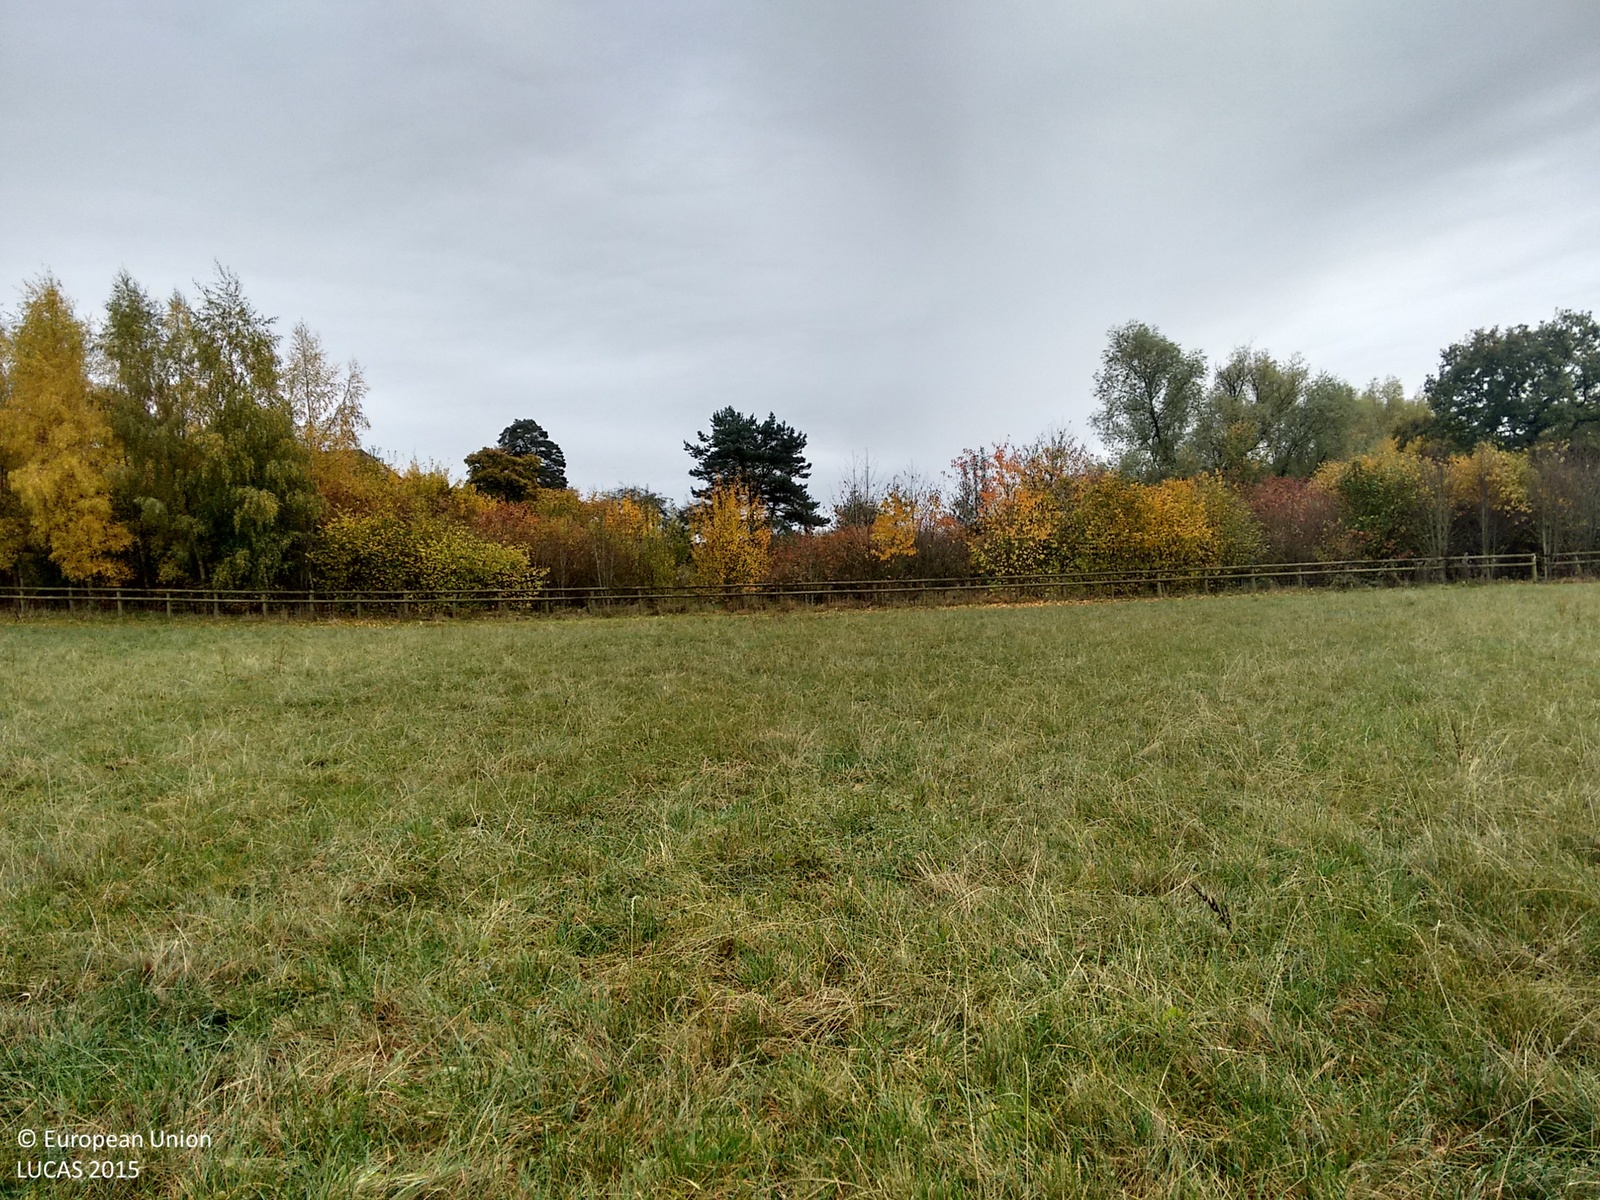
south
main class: Grassland
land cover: Grassland without tree/shrub cover
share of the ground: > 75 %
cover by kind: herbaceous plants 100 %
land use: Agriculture (excluding fallow land and kitchen gardens)
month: October
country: GB
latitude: 52.3505
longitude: -2.5011
